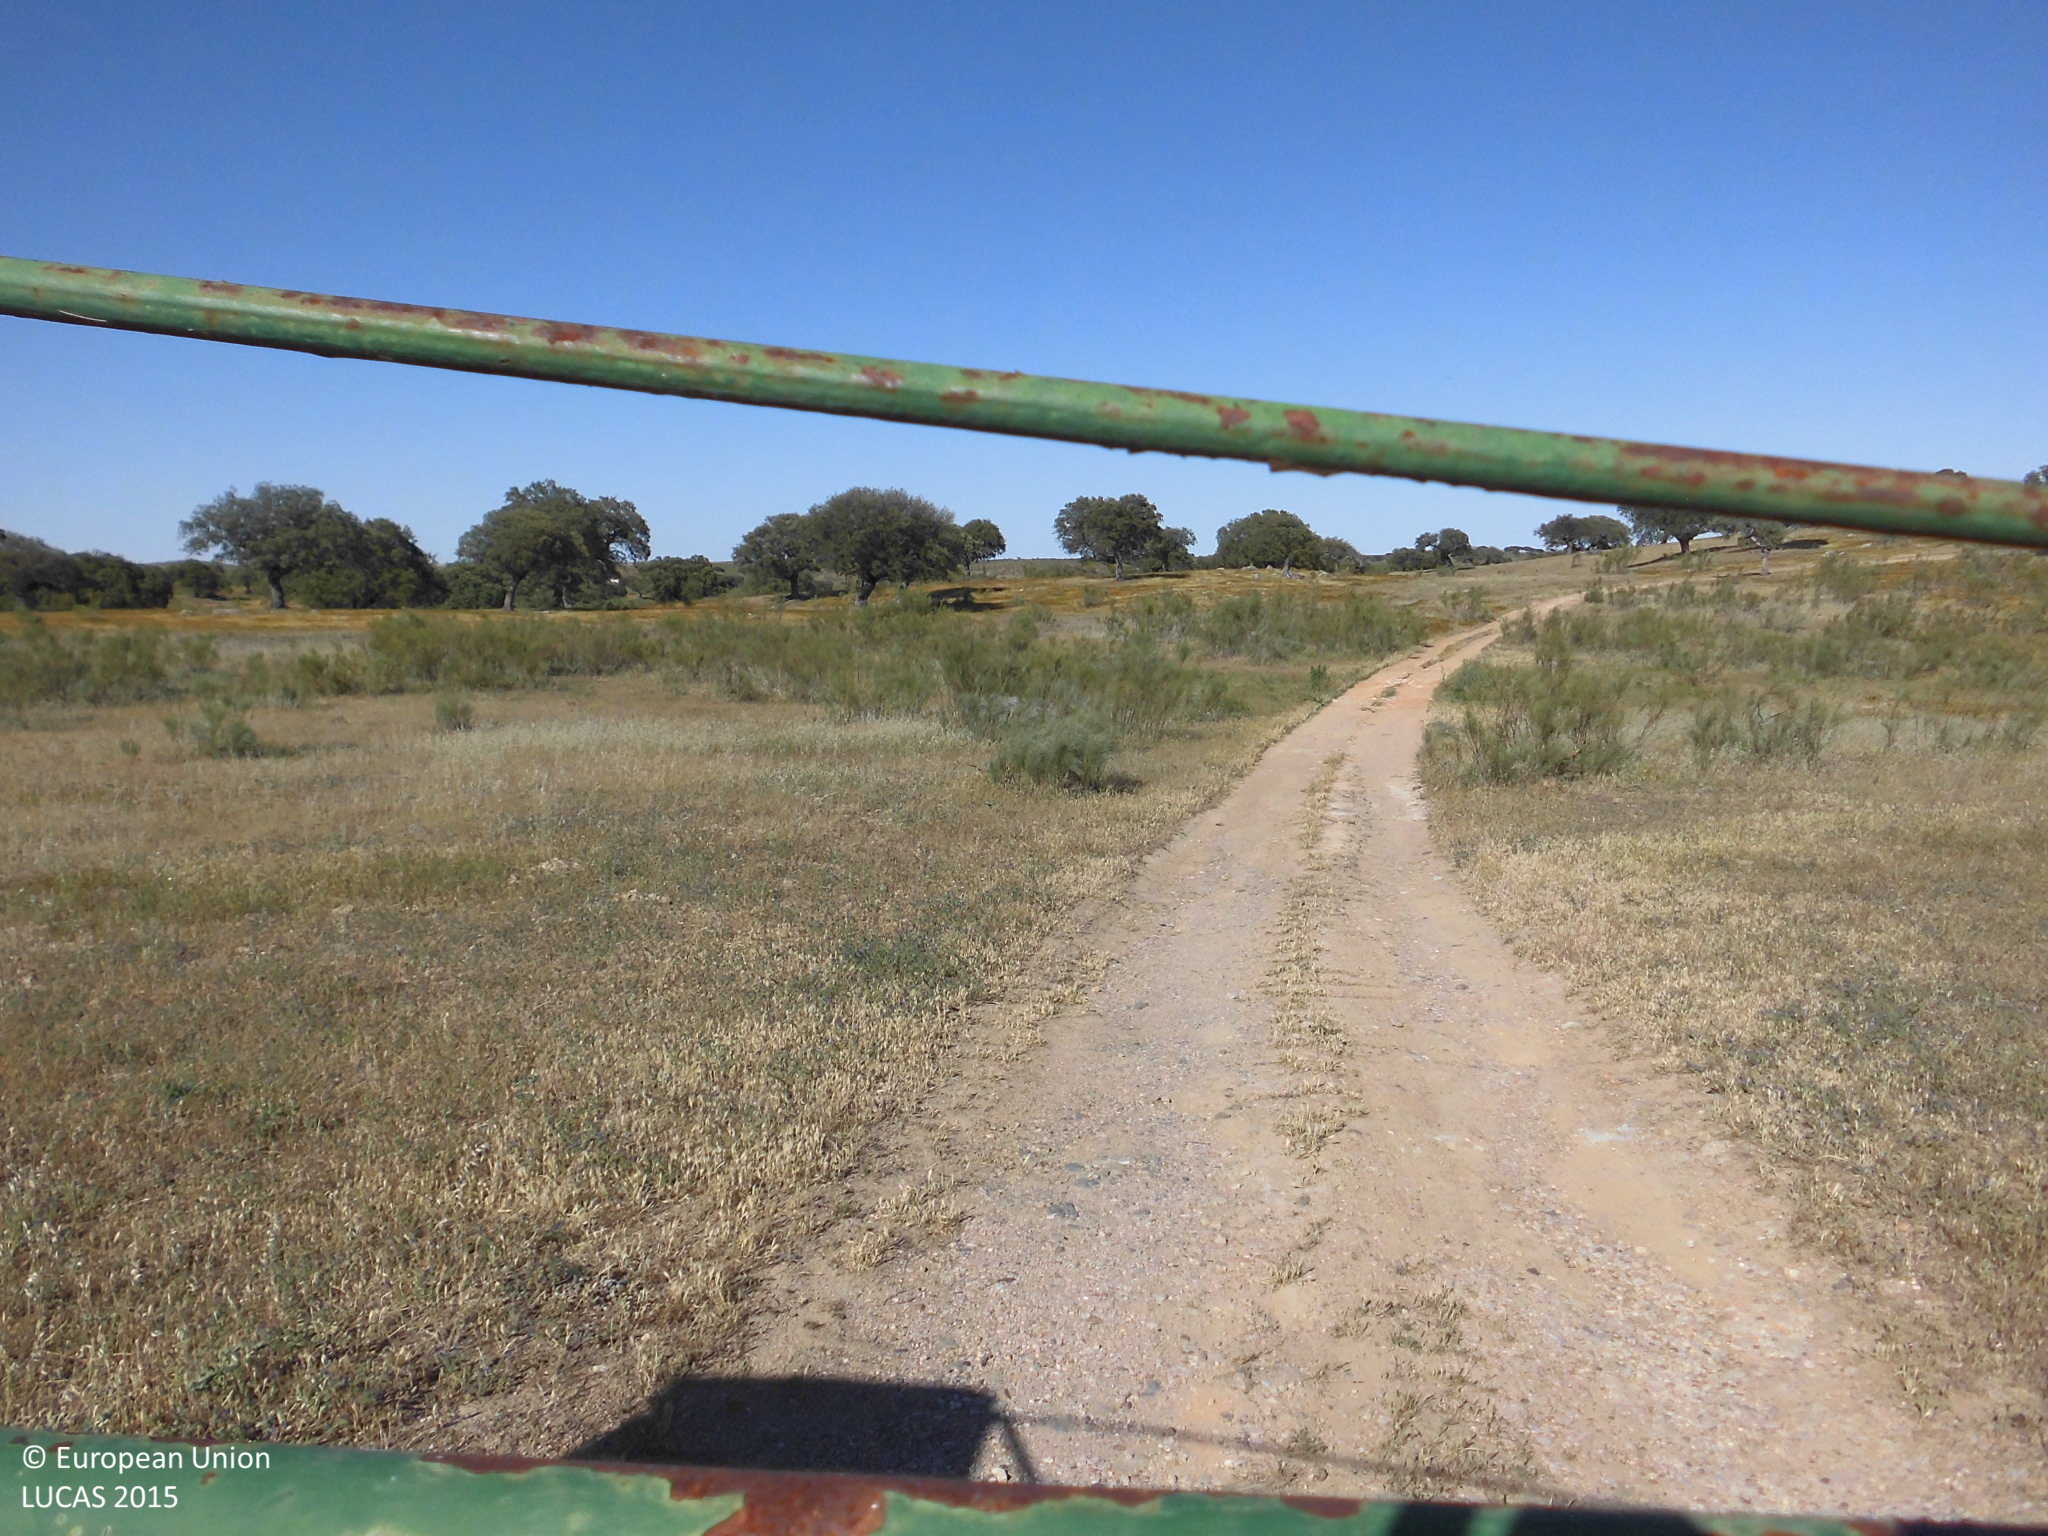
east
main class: Shrubland
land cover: Shrubland without tree cover
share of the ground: 10 - 25 %
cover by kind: herbaceous plants 80 %, shrubs 20 %
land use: Agriculture (excluding fallow land and kitchen gardens)
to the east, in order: Shrubland without tree cover; Grassland with sparse tree/shrub cover; Fences; Broadleaved woodland
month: May
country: ES
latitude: 39.4796
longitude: -6.8538
